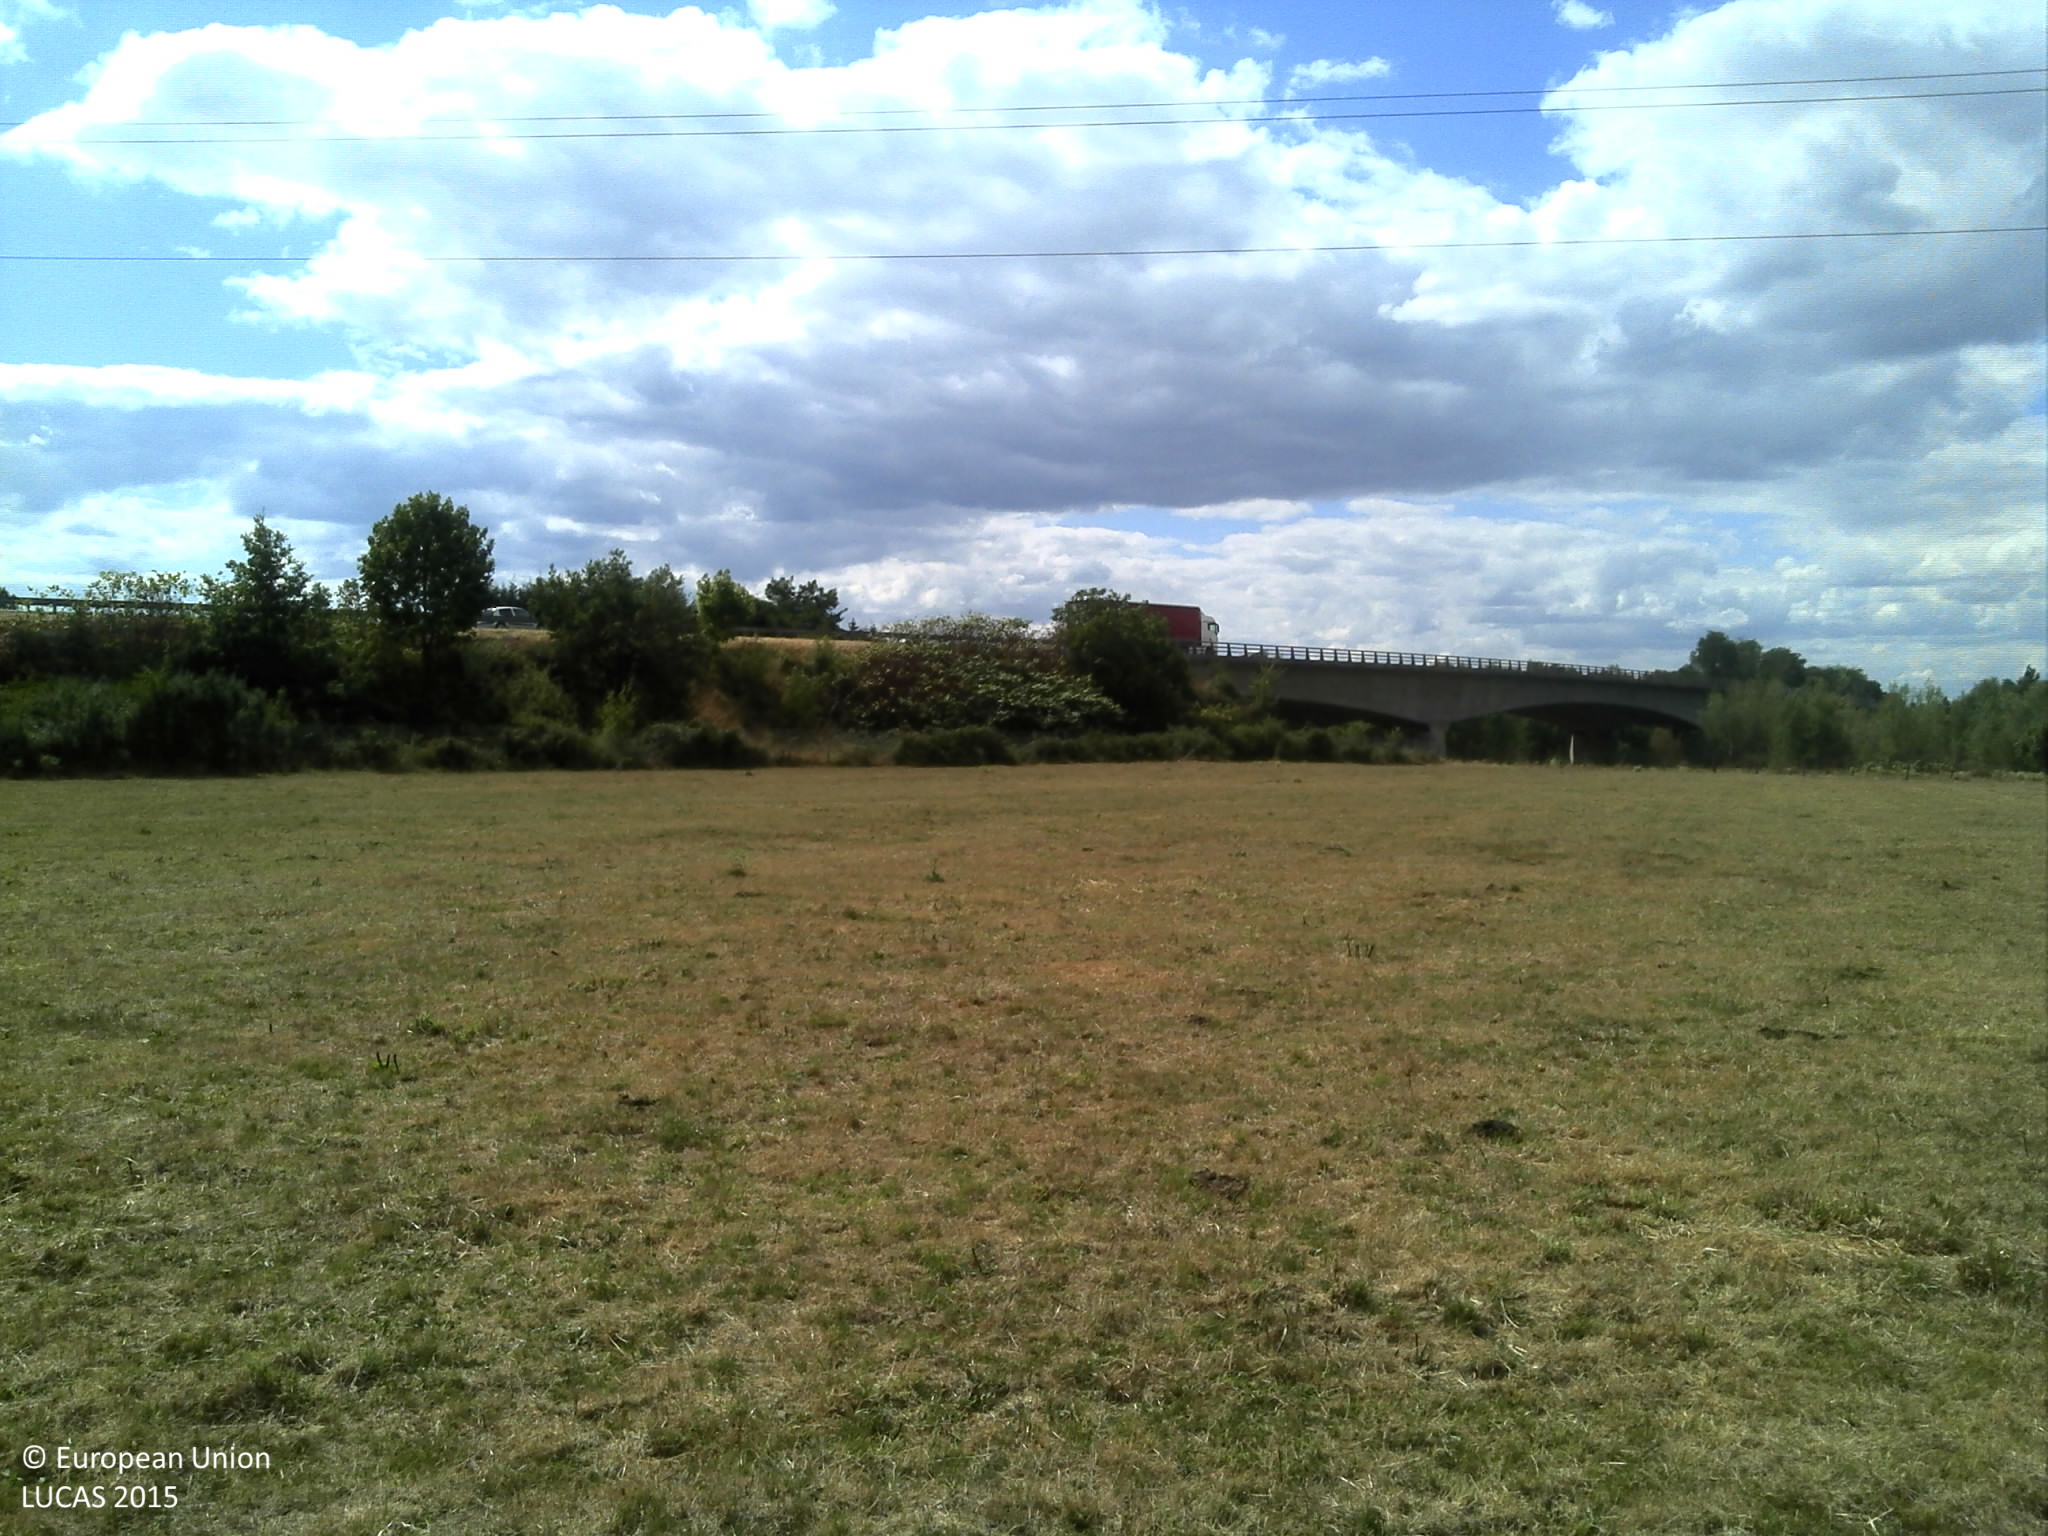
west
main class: Grassland
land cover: Grassland without tree/shrub cover
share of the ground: > 75 %
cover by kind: herbaceous plants 100 %
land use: Agriculture (excluding fallow land and kitchen gardens)
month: July
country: FR
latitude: 46.0436
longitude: 4.0960
